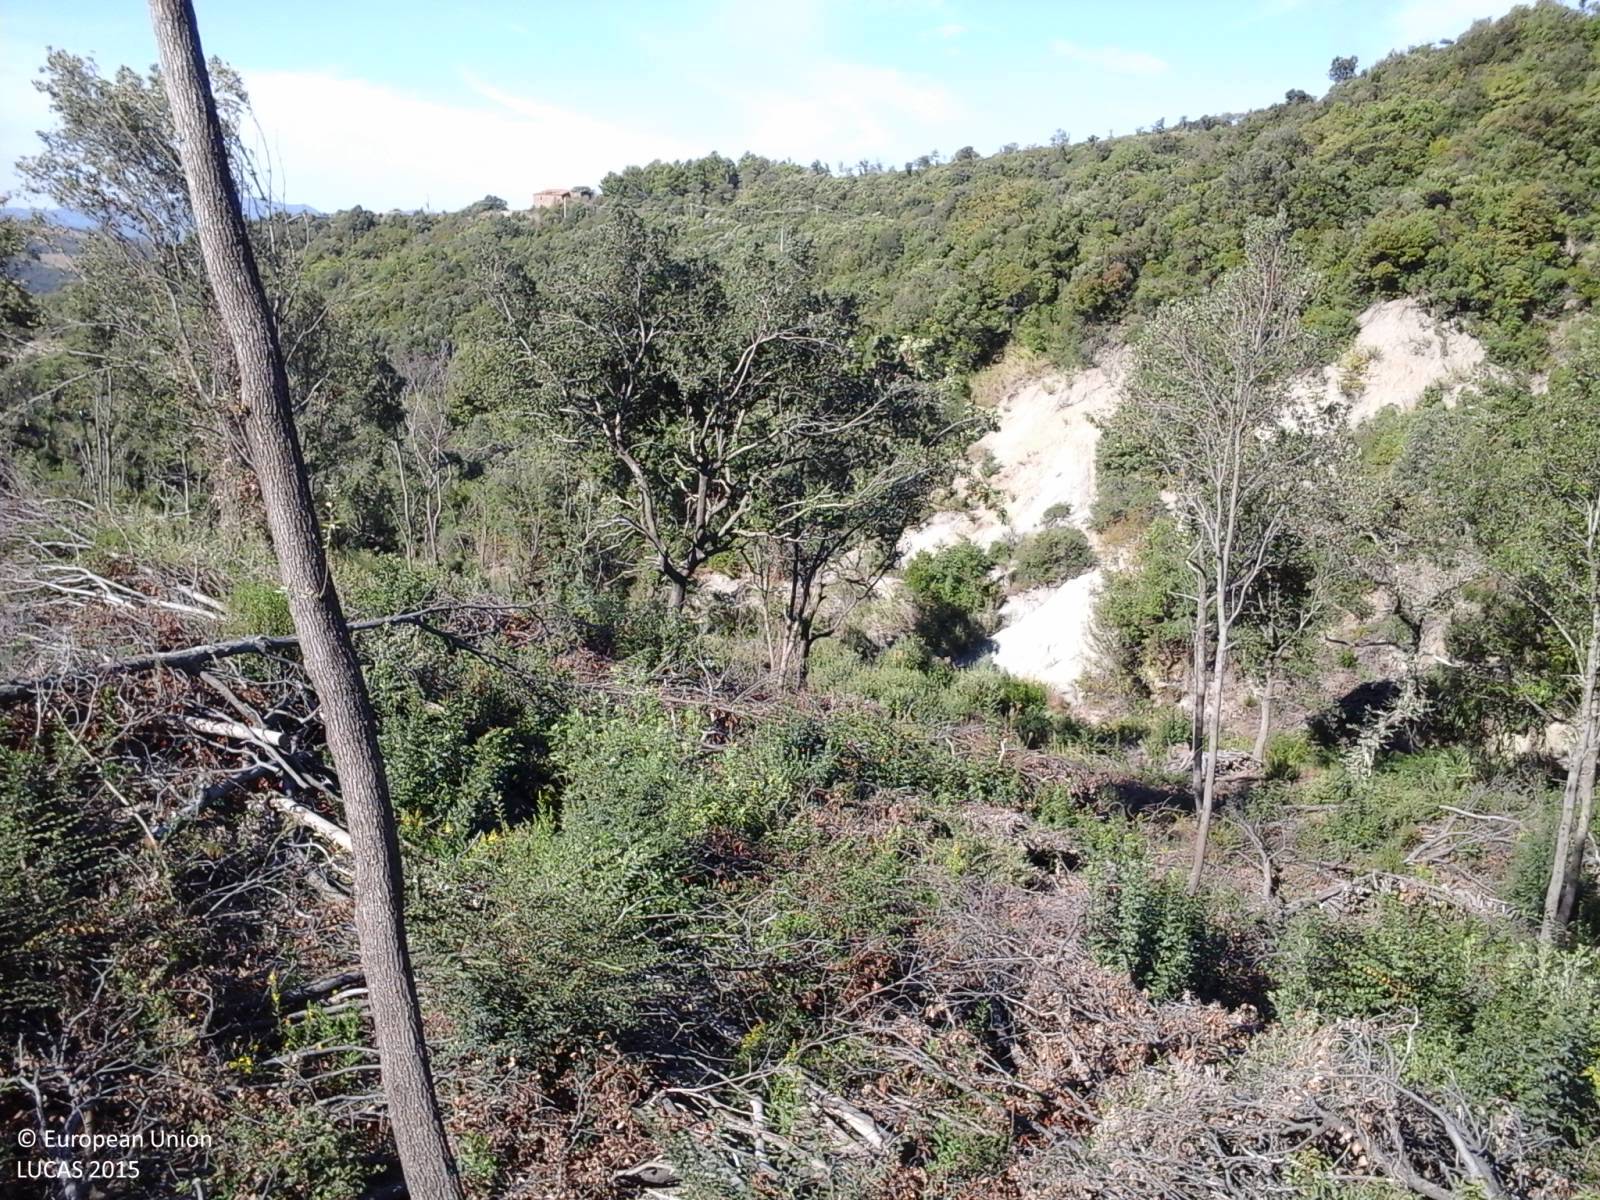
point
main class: Woodland
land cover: Broadleaved woodland
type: thermophilous deciduous forest
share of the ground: > 75 %
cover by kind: broadleaved forest trees 80 %, shrubs 20 %
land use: Forestry
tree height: > 5 m
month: September
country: IT
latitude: 43.1380
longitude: 10.8457
